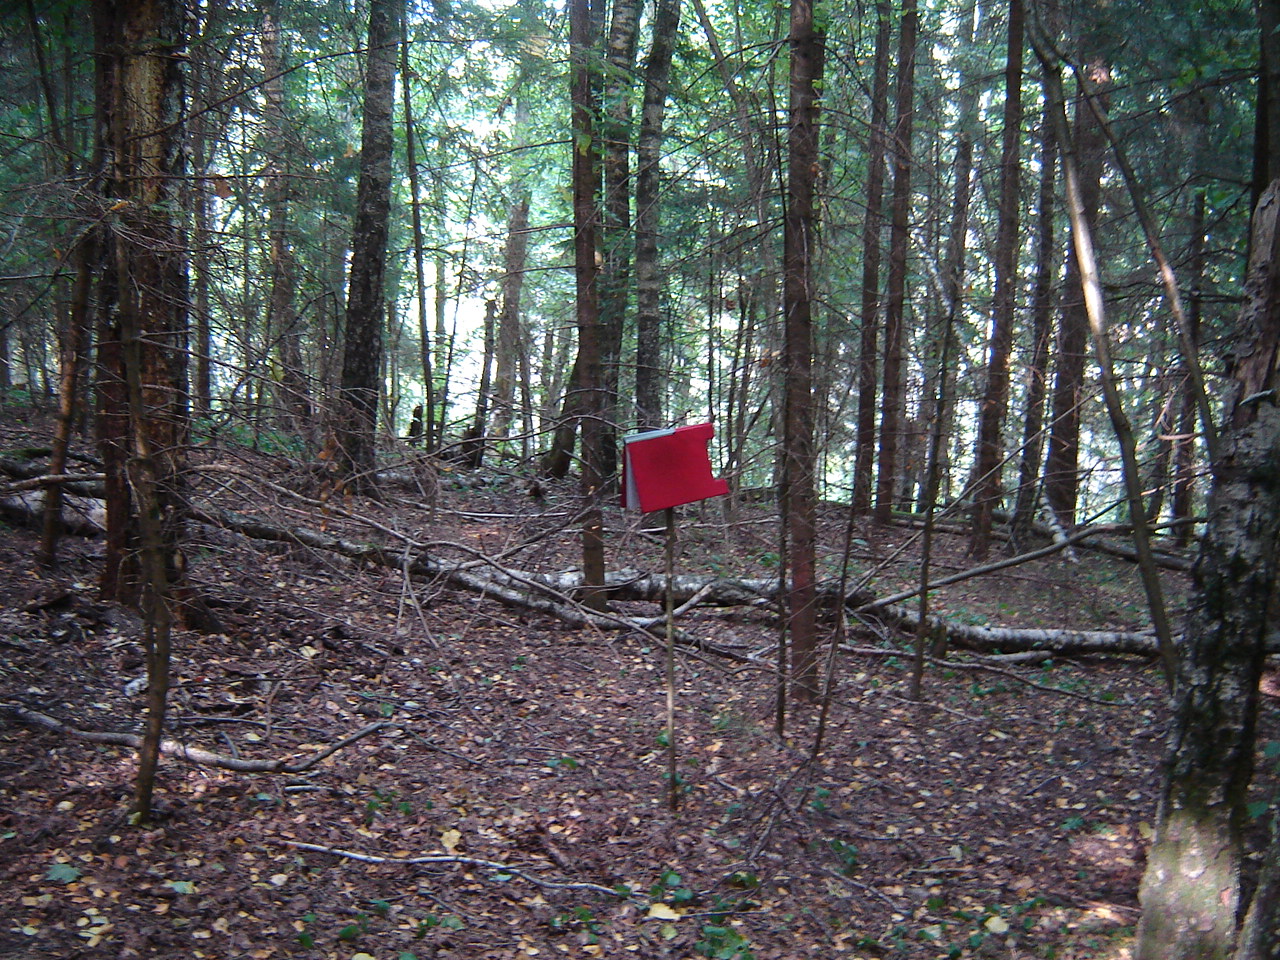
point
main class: Woodland
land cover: Spruce dominated mixed woodland
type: hemiboreal forest and nemoral coniferous forest and mixed broadleaved-coniferous forest
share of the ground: > 75 %
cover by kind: broadleaved forest trees 50 %, coniferous forest trees 45 %, unconsolidated bare surface 5 %
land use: Forestry
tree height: > 5 m
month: August
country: LT
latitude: 54.7236
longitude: 24.9086
